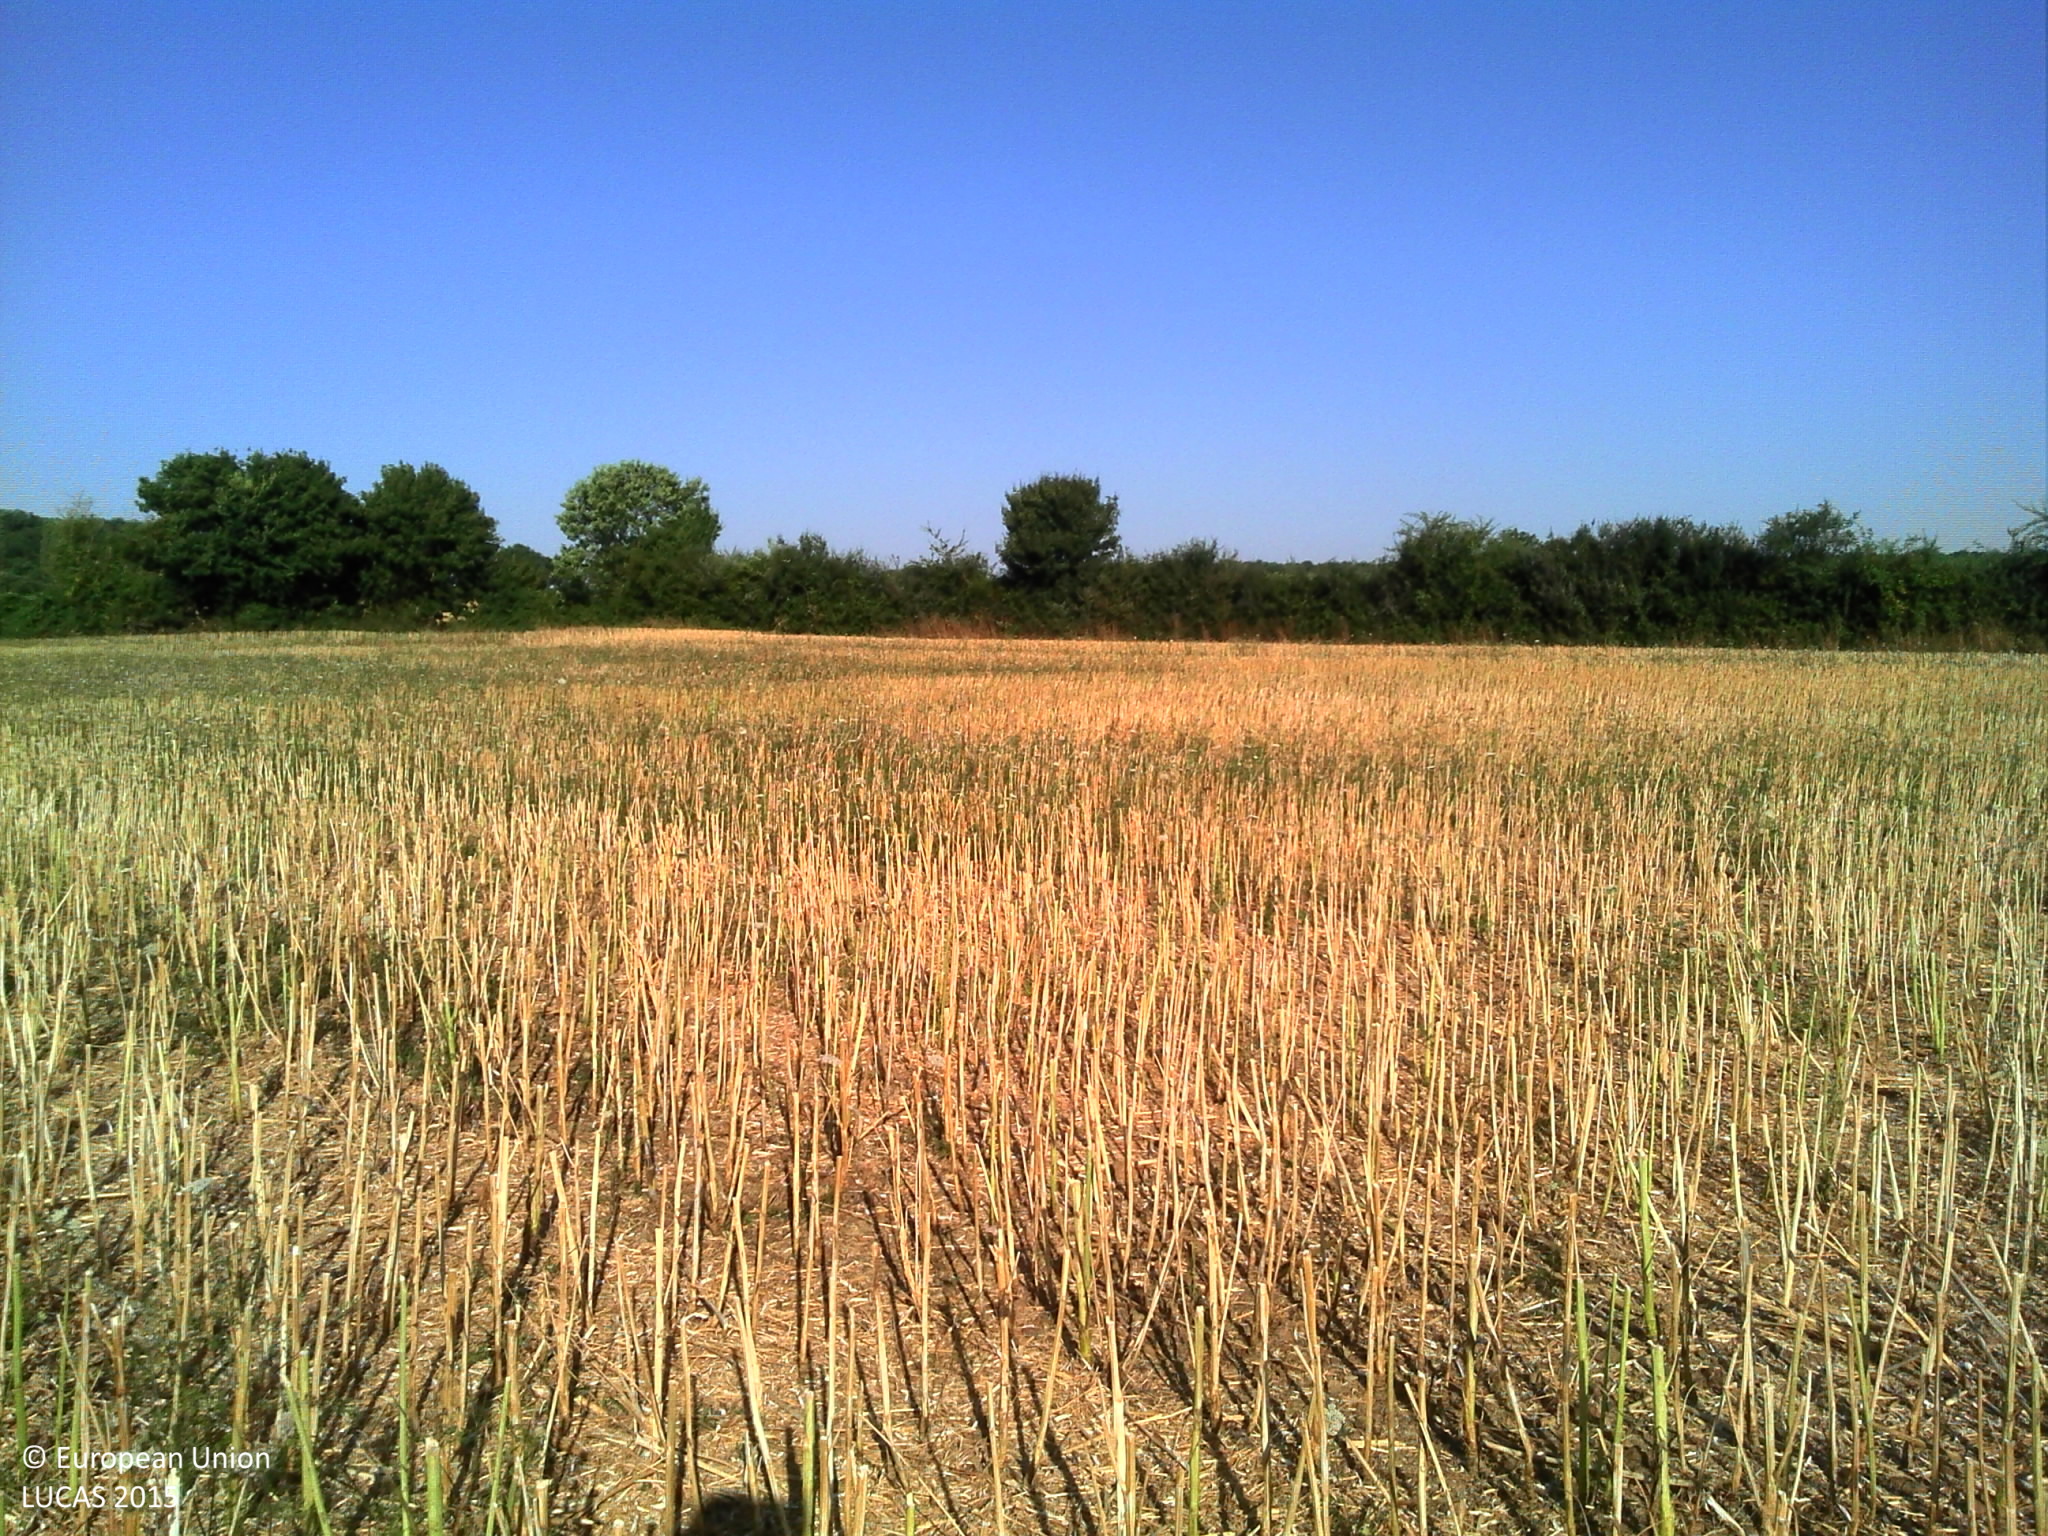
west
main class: Cropland
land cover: Rape and turnip rape
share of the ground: < 10 %
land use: Agriculture (excluding fallow land and kitchen gardens)
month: July
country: FR
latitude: 46.5386
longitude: 0.2397
